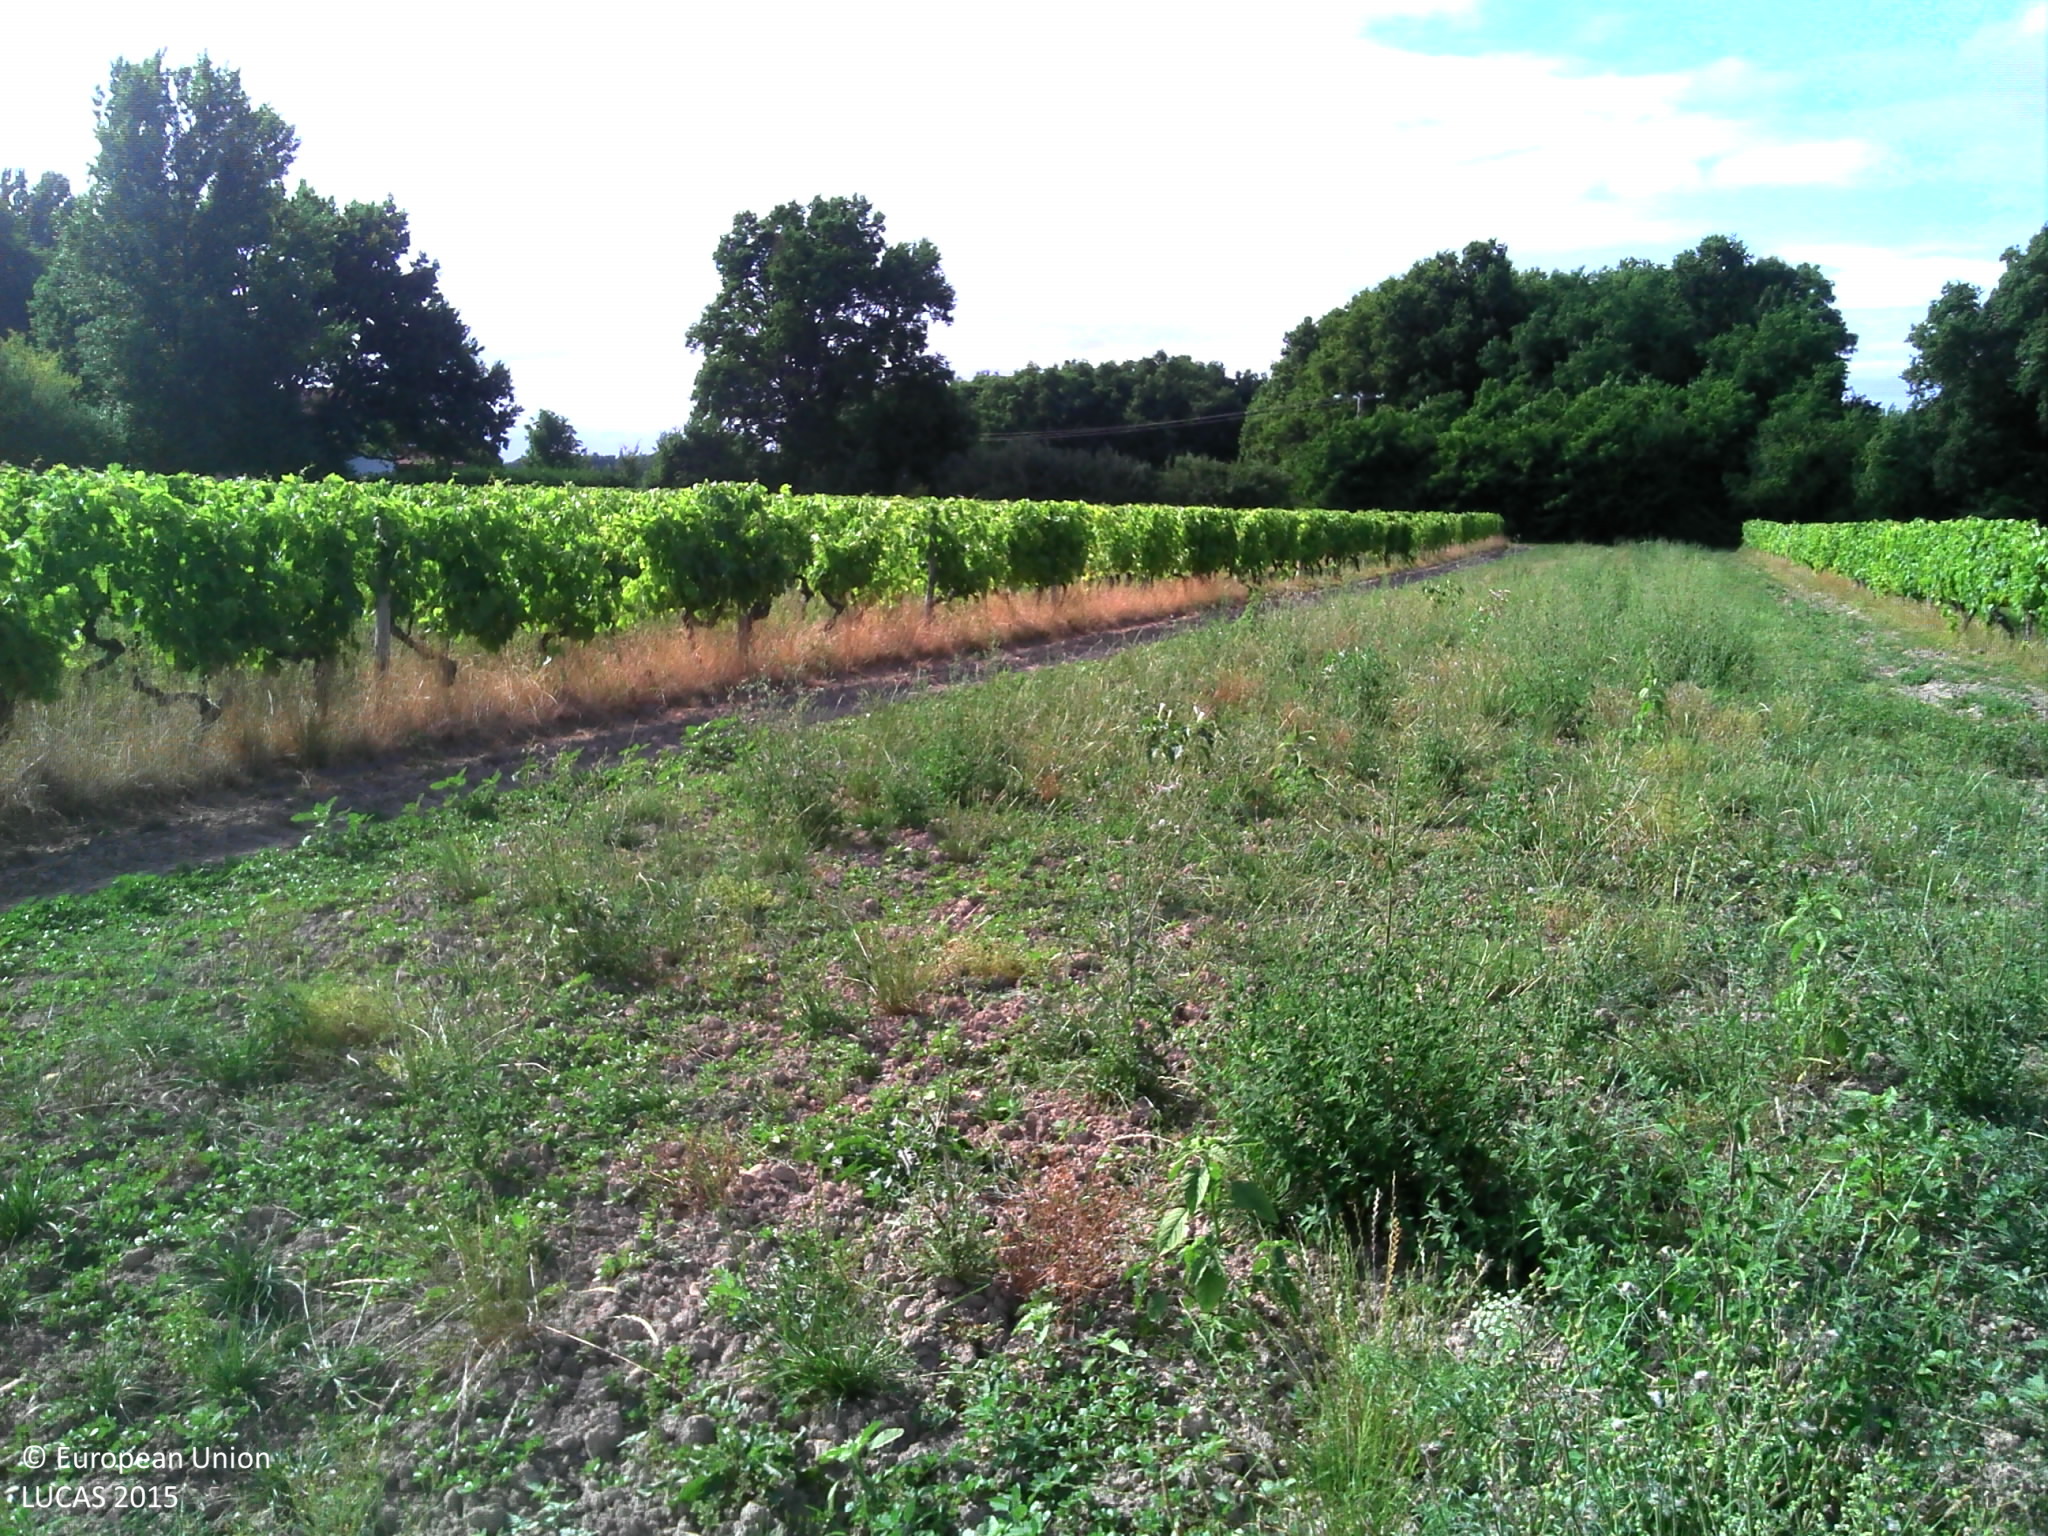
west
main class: Grassland
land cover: Spontaneously vegetated surfaces
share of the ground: > 75 %
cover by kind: herbaceous plants 95 %, shrubs 5 %
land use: Fallow land
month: July
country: FR
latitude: 45.5131
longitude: -0.7898
